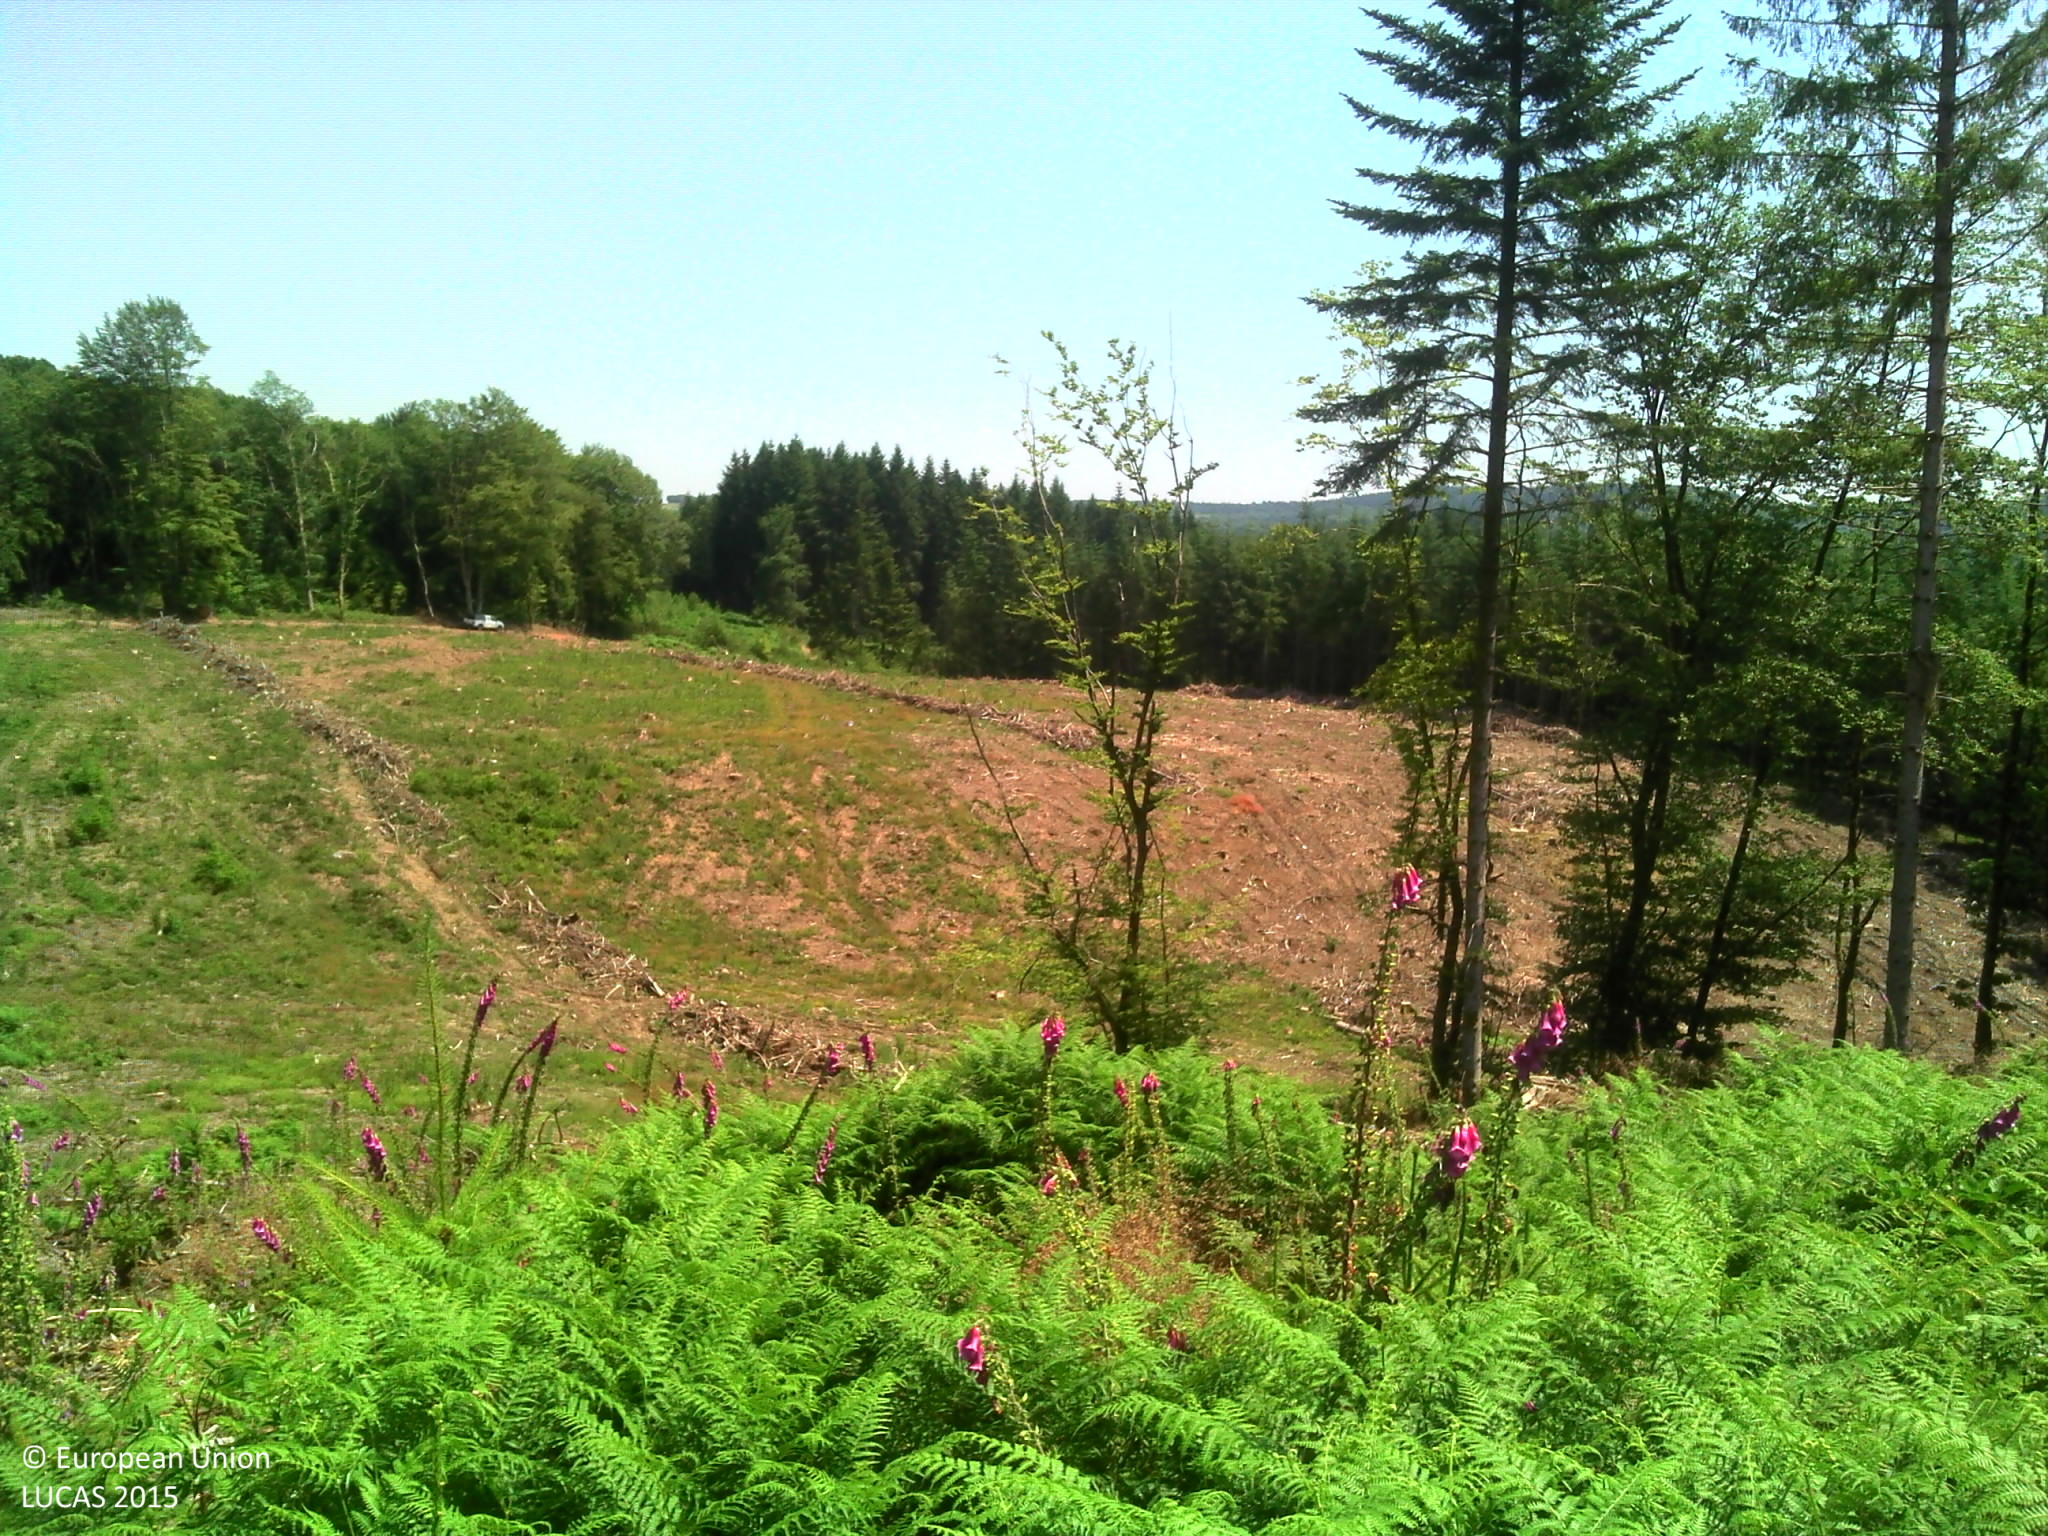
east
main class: Woodland
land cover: Spruce dominated coniferous woodland
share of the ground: > 75 %
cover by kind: coniferous forest trees 100 %
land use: Forestry
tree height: < 5 m
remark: Clear cut
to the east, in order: Spruce dominated coniferous woodland
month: July
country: FR
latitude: 47.1397
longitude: 3.9993
